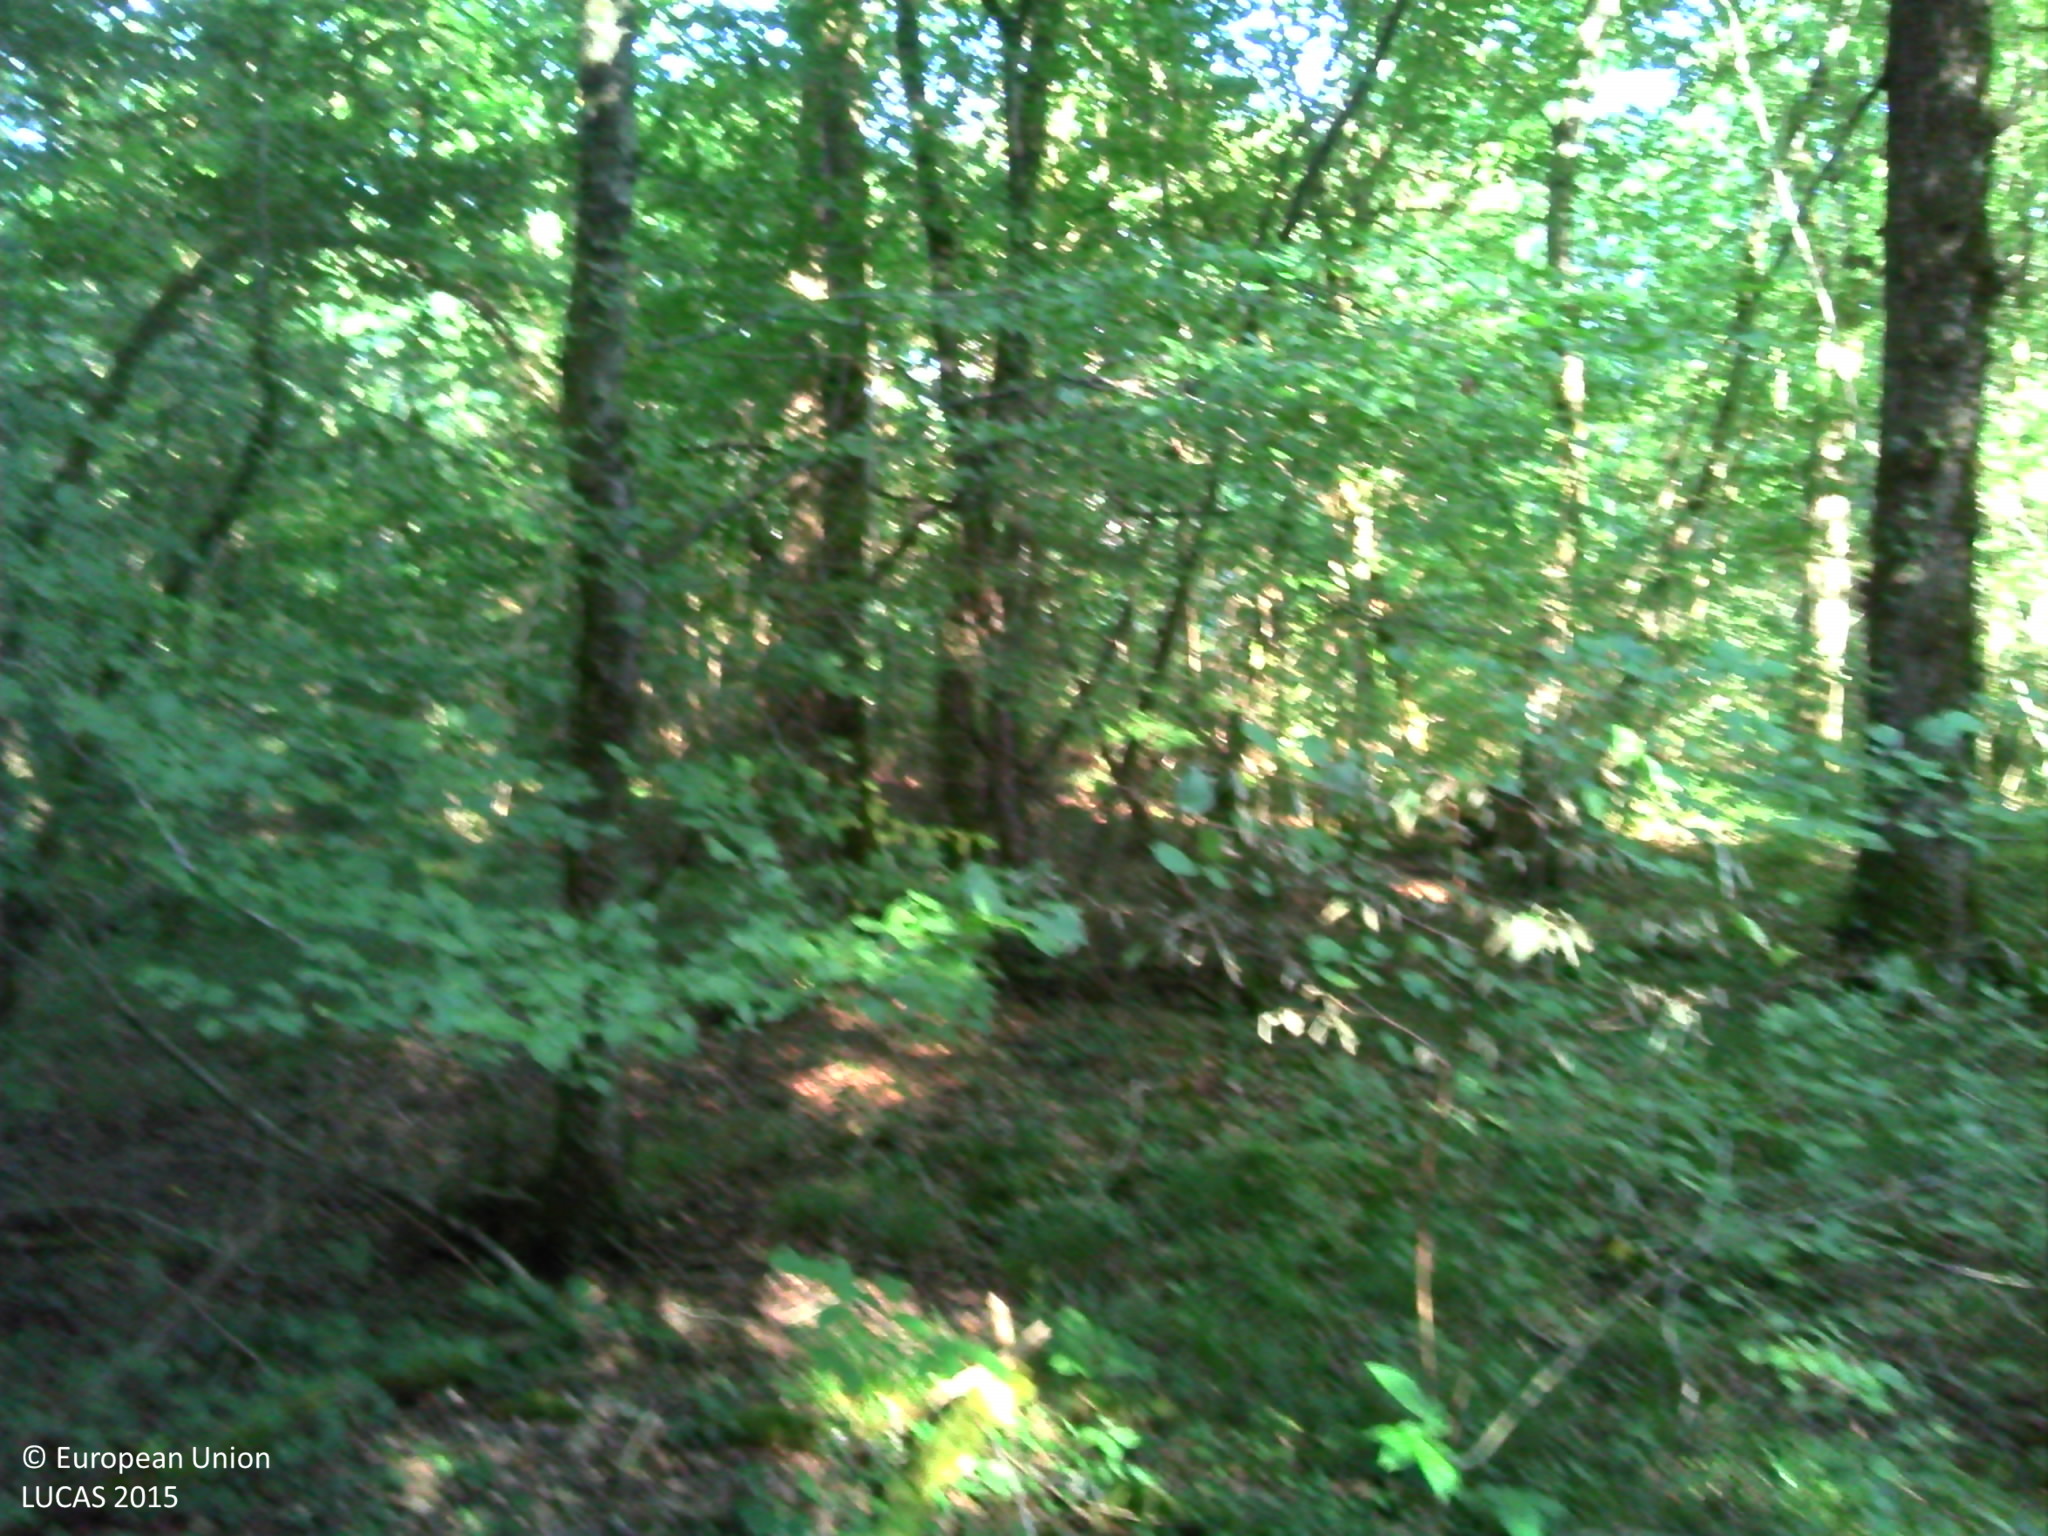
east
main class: Woodland
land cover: Broadleaved woodland
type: mesophytic deciduous forest
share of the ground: > 75 %
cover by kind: broadleaved forest trees 100 %
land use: Forestry
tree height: > 5 m
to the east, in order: Broadleaved woodland
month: August
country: FR
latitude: 47.1793
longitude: 2.0868
